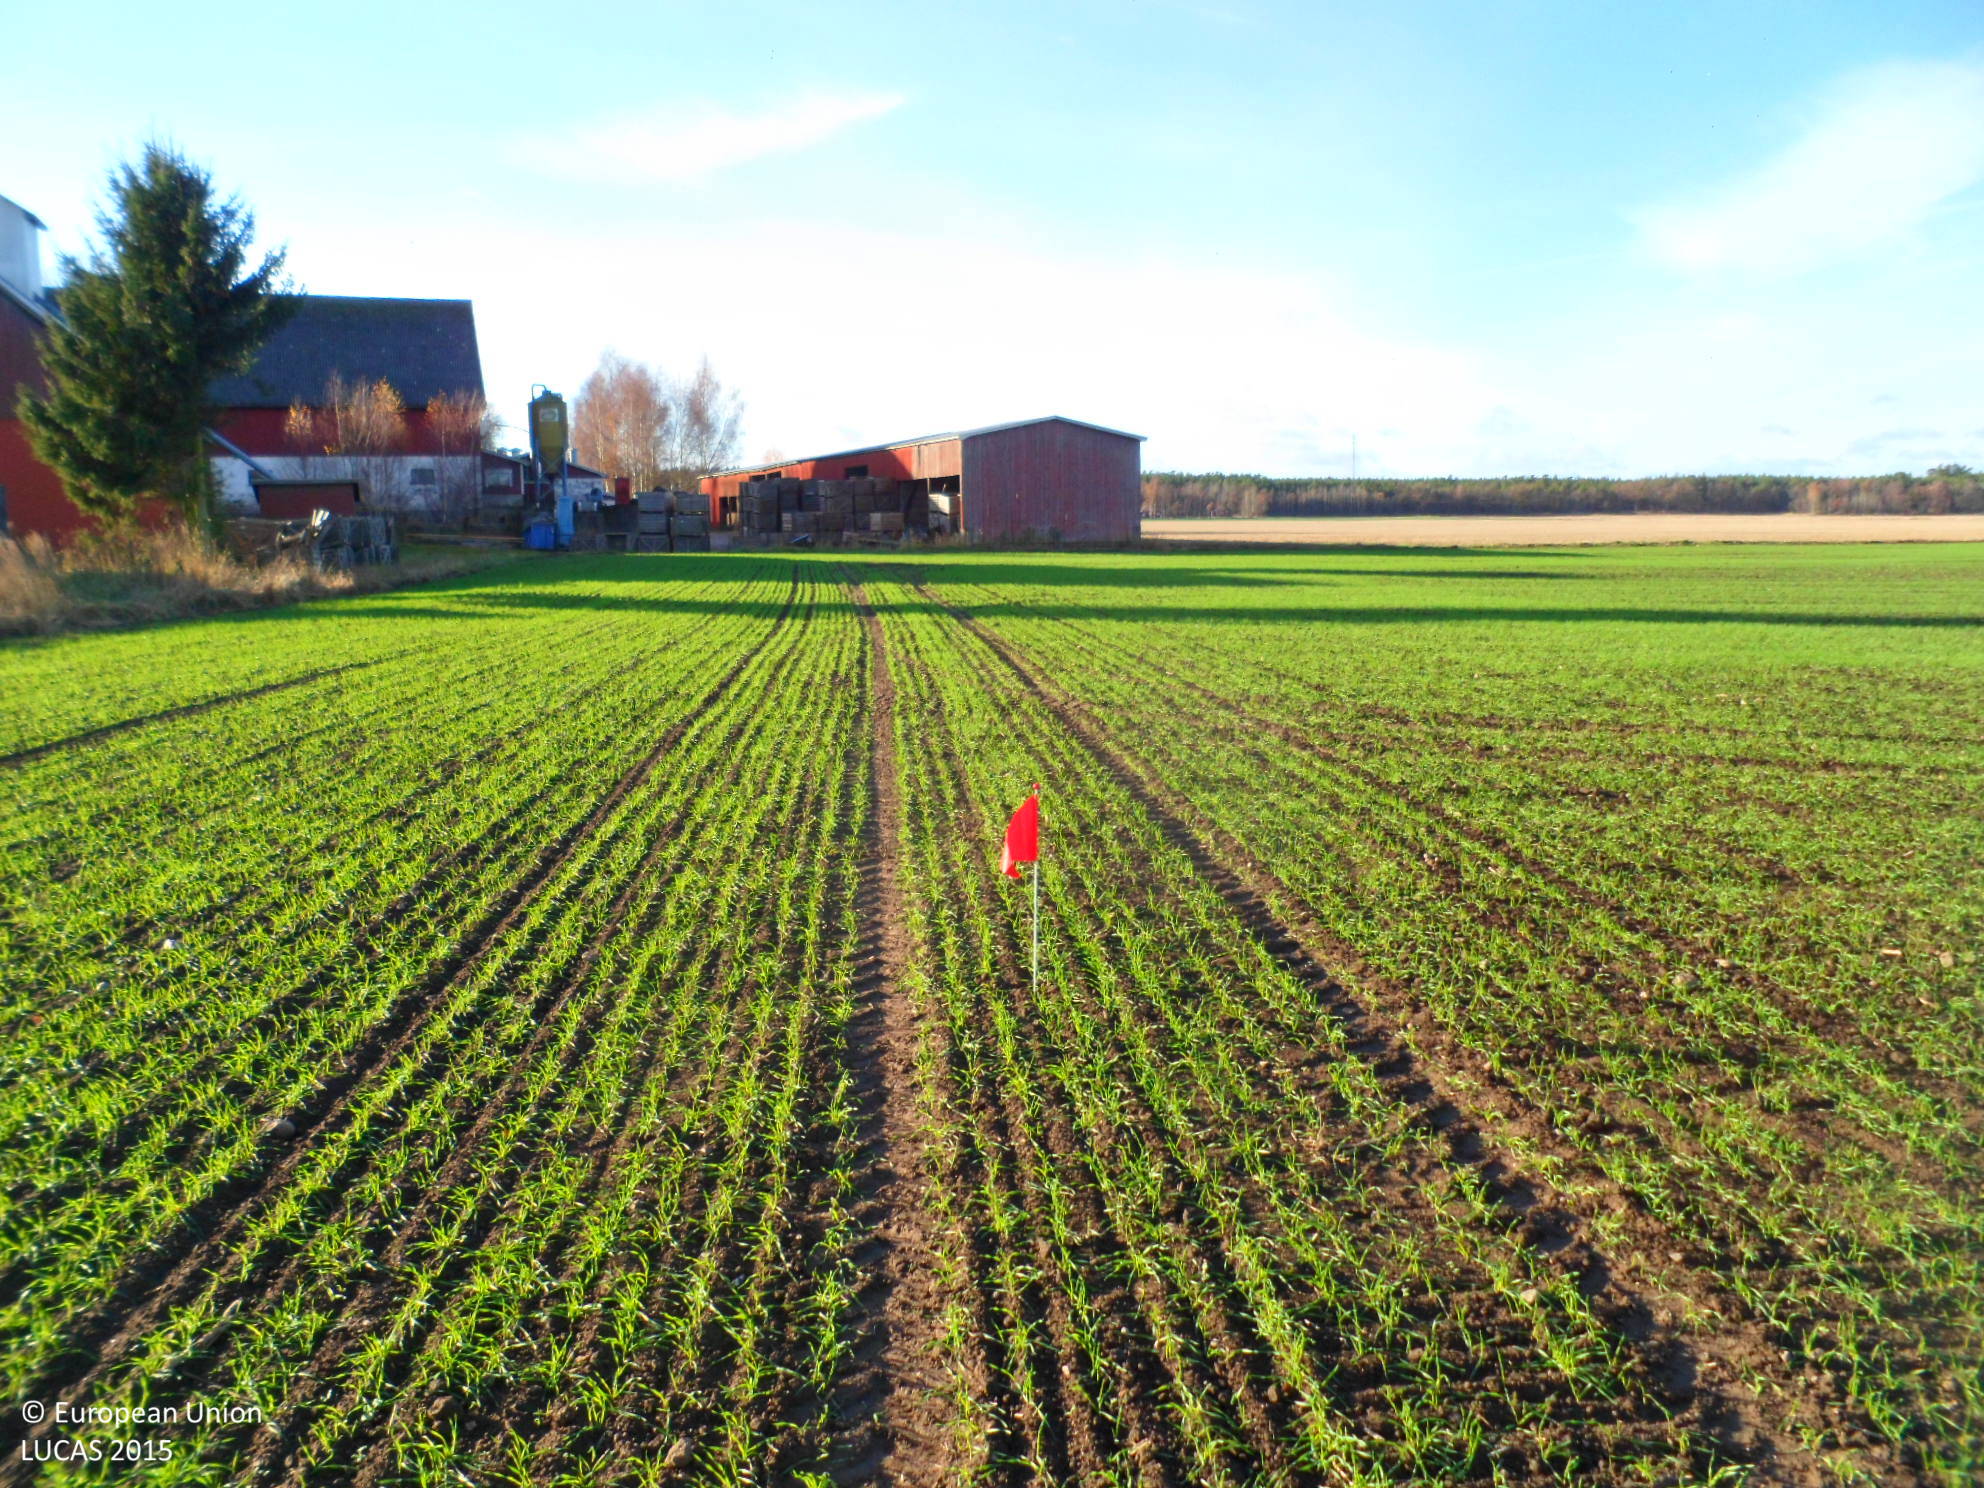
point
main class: Cropland
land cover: Common wheat
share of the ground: 25 - 50 %
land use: Agriculture (excluding fallow land and kitchen gardens)
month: November
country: SE
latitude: 56.5789
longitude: 16.2030
